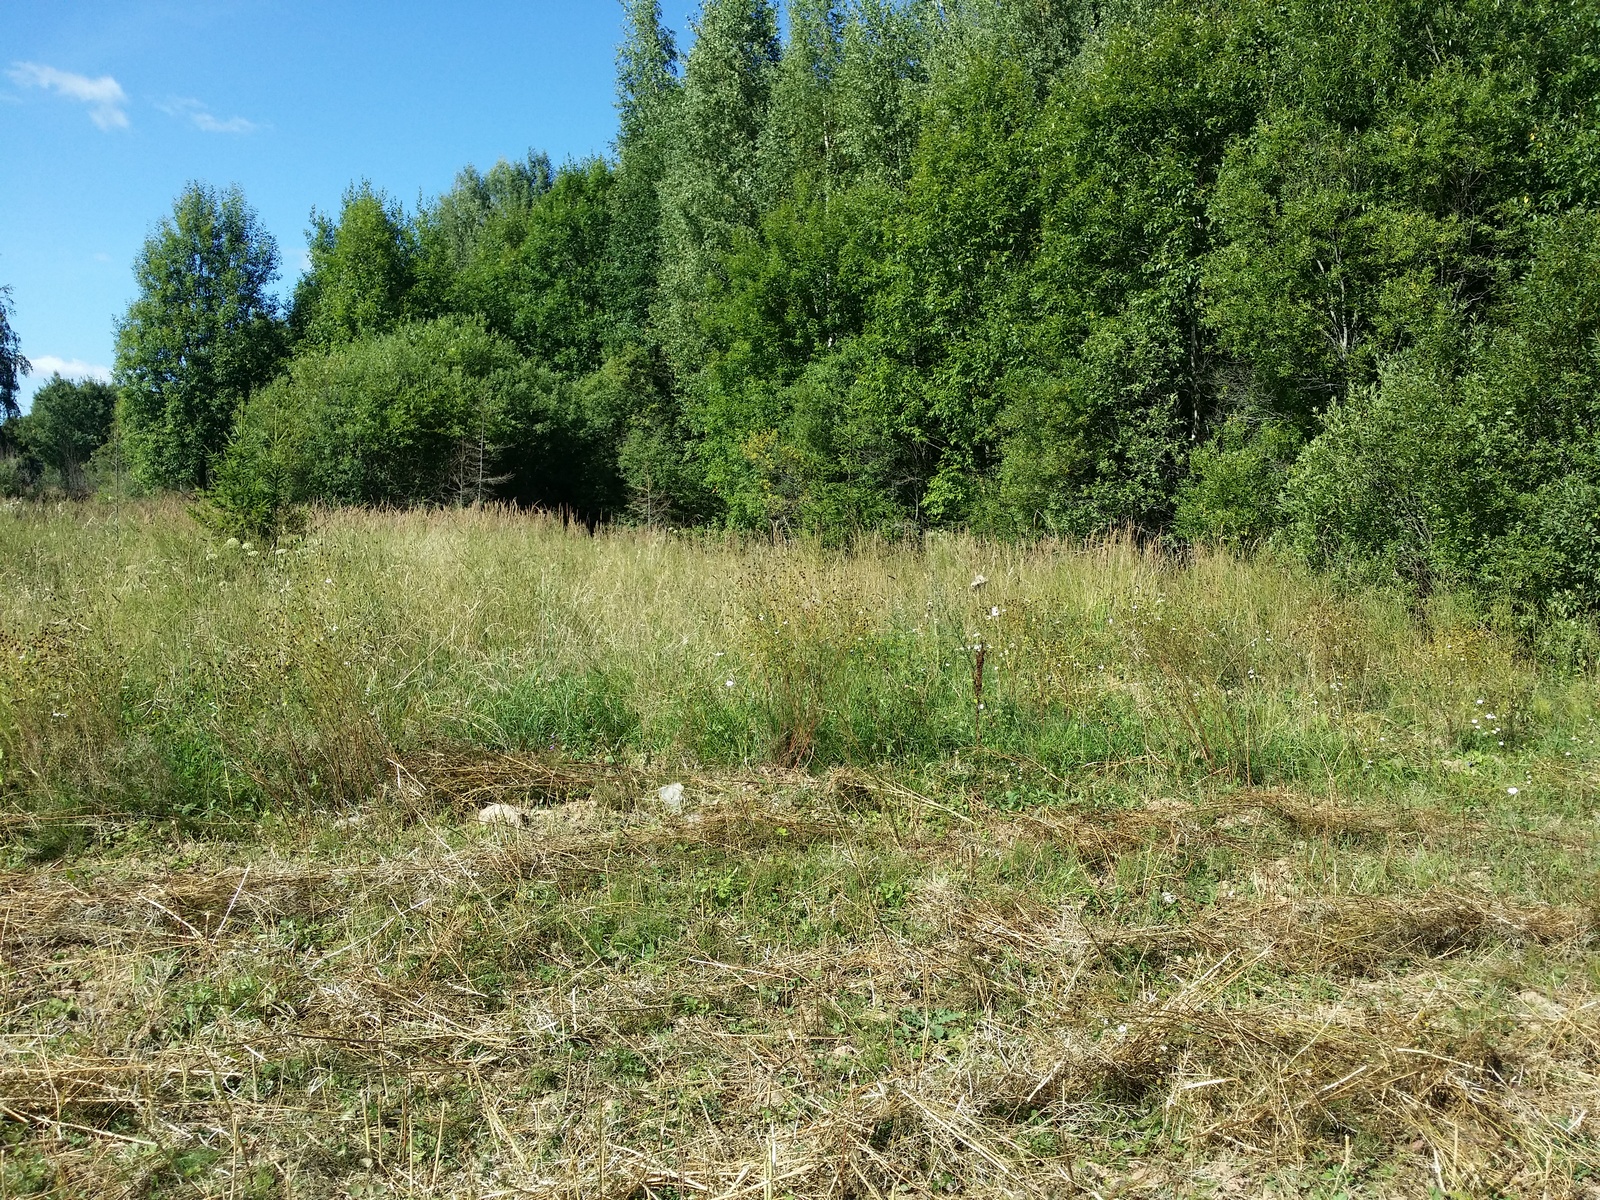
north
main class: Cropland
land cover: Rape and turnip rape
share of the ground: < 10 %
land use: Agriculture (excluding fallow land and kitchen gardens)
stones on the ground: < 10 %
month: August
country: LV
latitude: 57.0734
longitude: 27.5132
